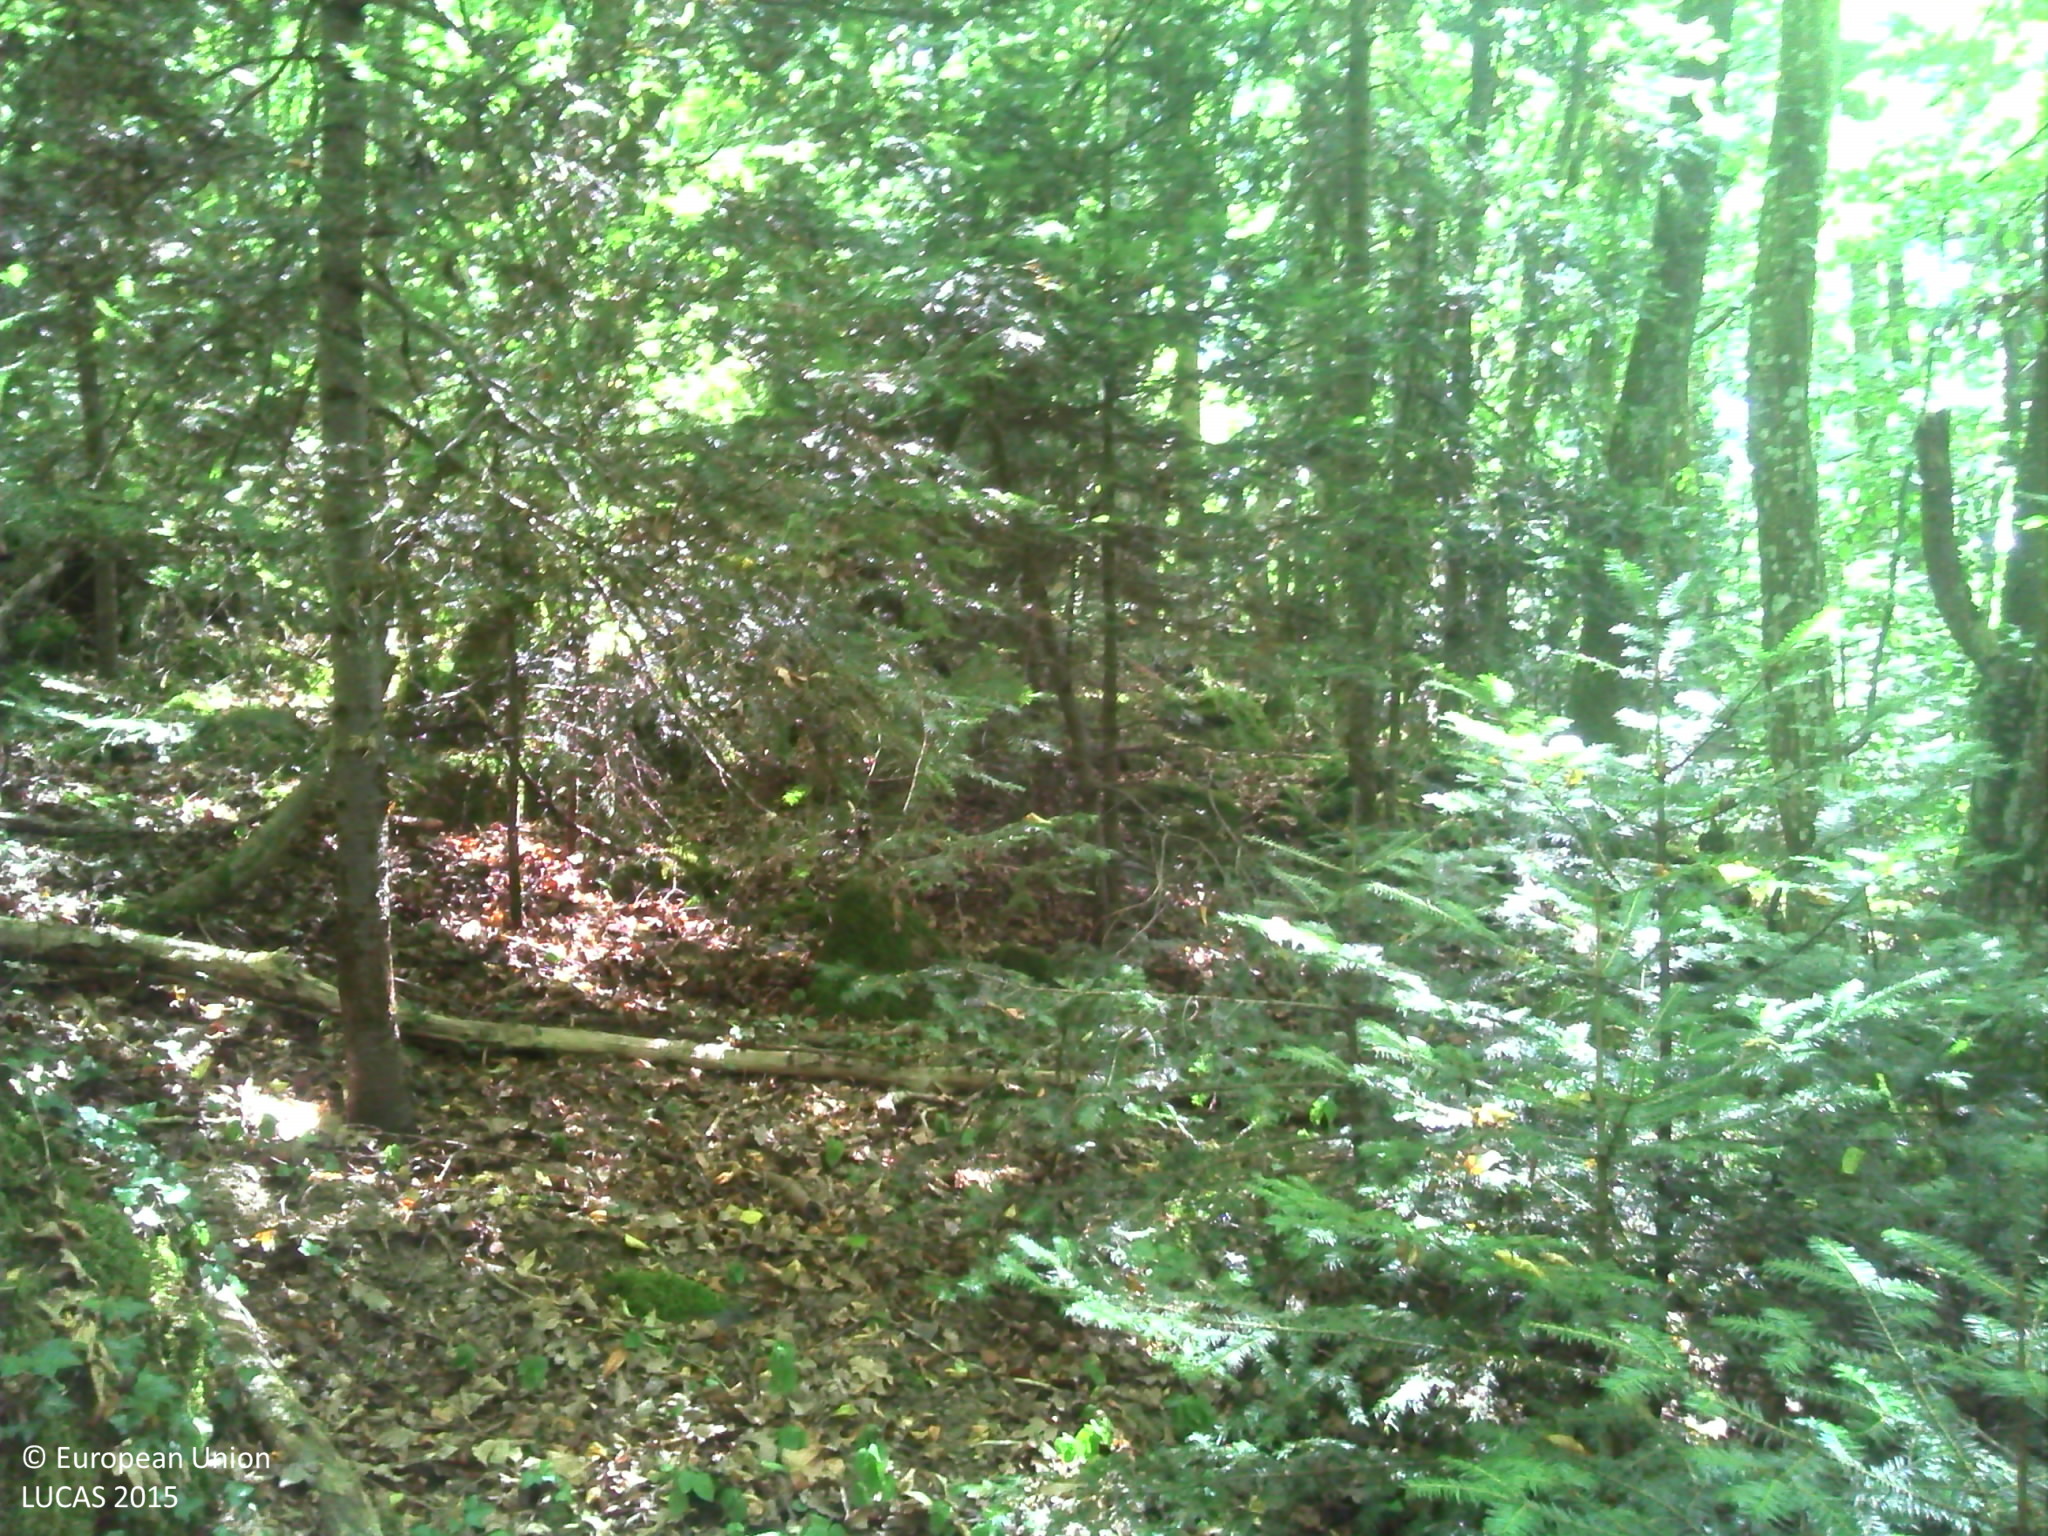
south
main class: Woodland
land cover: Other mixed woodland
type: mountainous beech forest
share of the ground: > 75 %
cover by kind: coniferous forest trees 40 %, broadleaved forest trees 40 %, herbaceous plants 20 %
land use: Forestry
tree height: > 5 m
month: July
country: FR
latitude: 45.7757
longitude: 4.4859
